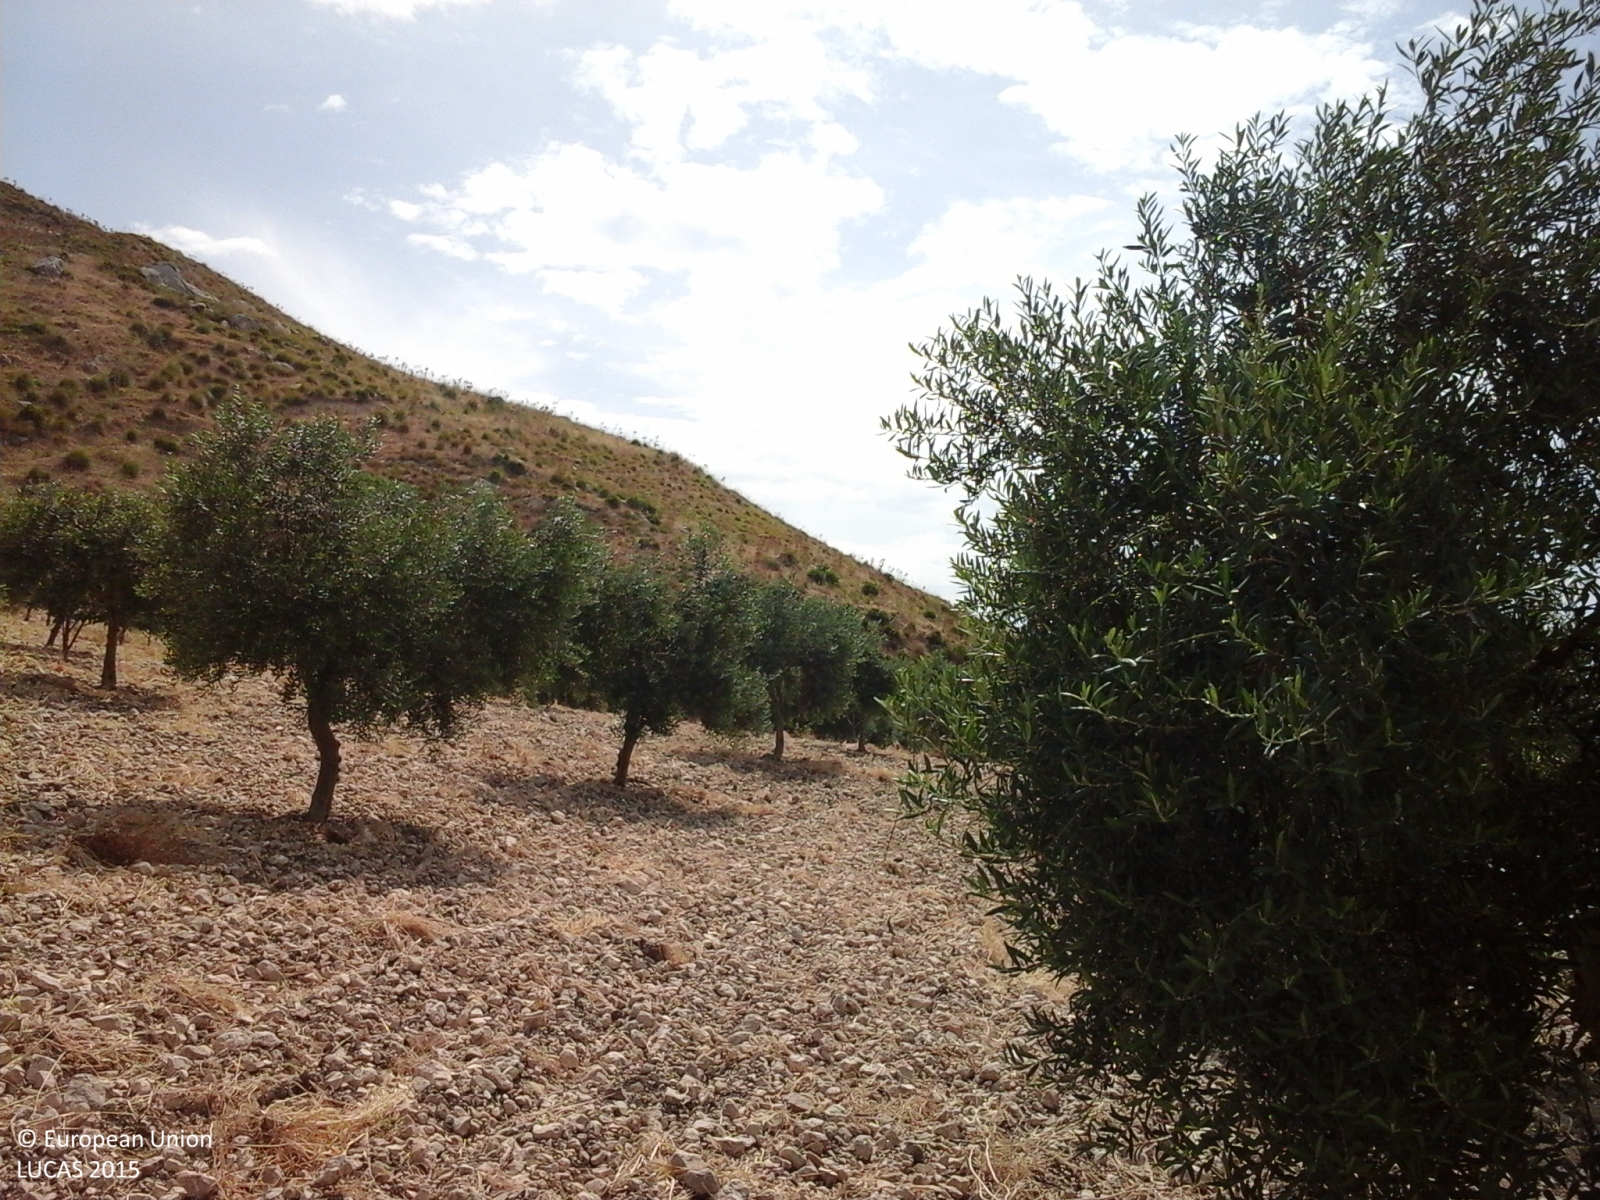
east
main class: Cropland
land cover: Olive groves
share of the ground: 25 - 50 %
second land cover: Other bare soil
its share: > 75 %
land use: Agriculture (excluding fallow land and kitchen gardens)
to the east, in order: Olive groves; Other bare soil; Shrubland without tree cover
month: June
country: IT
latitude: 37.5687
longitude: 13.1349
